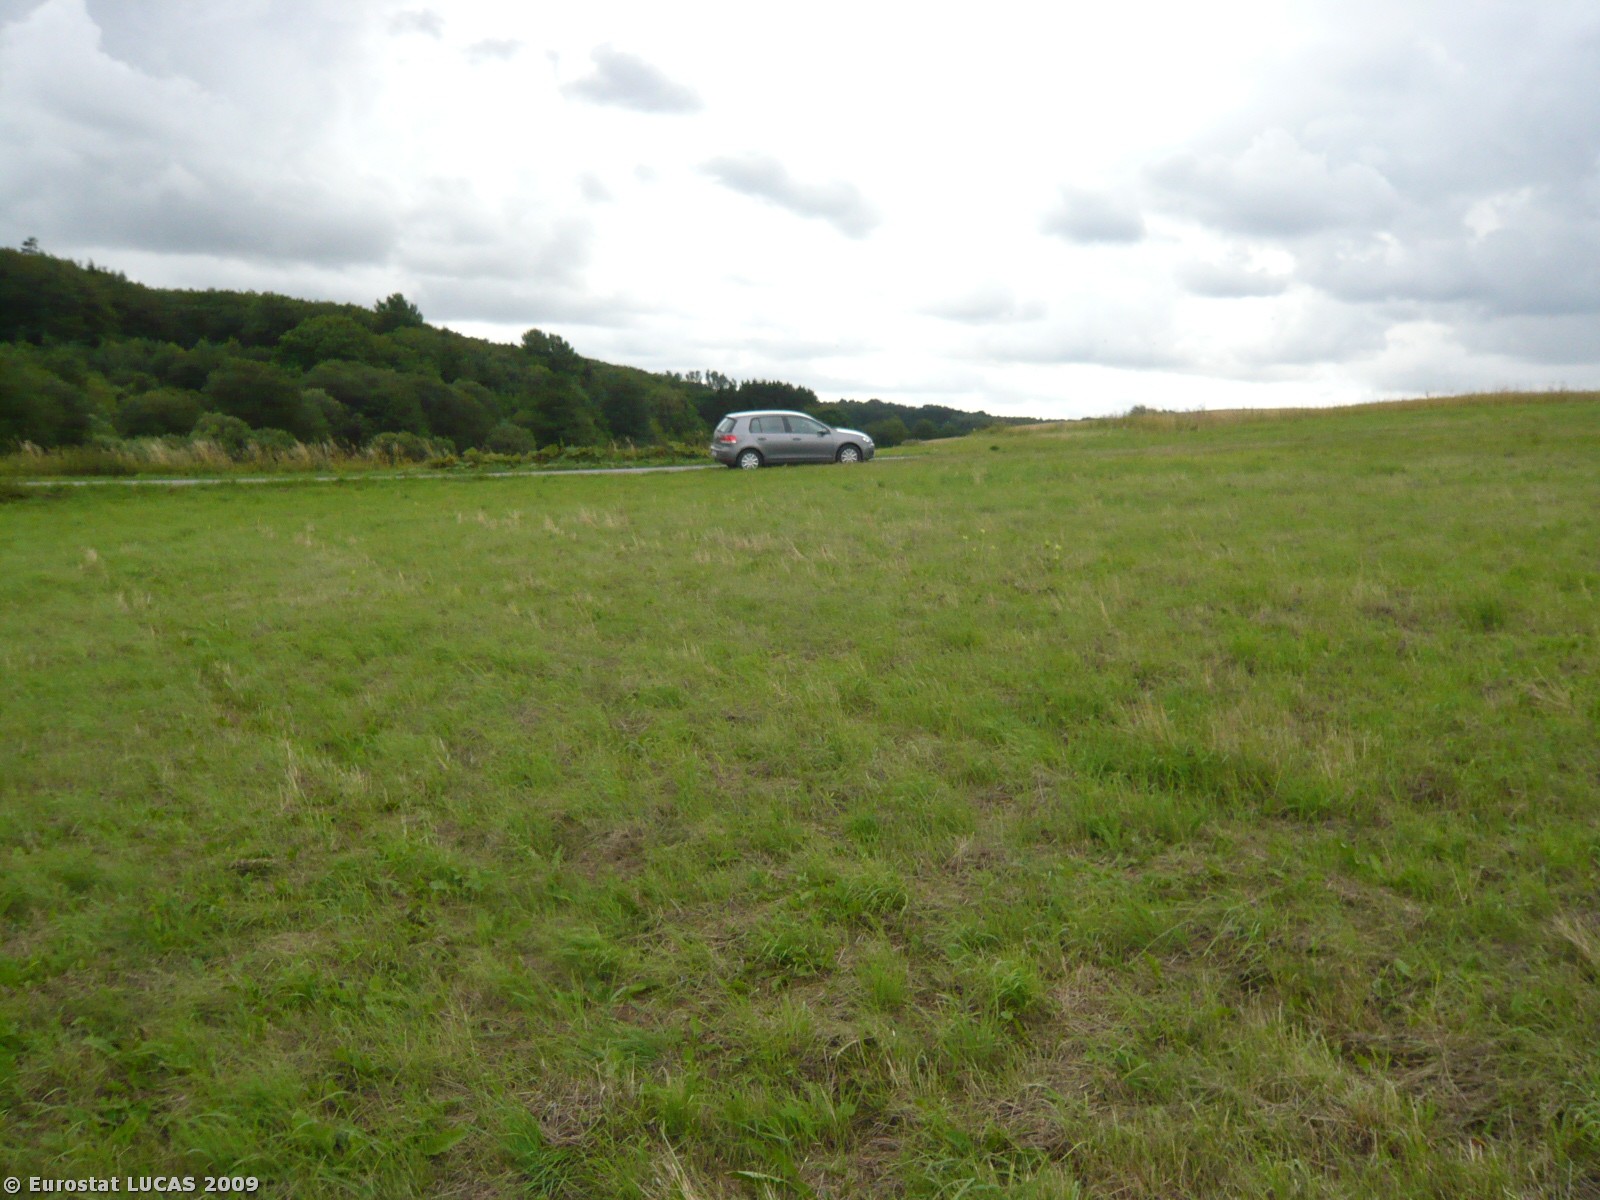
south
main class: Grassland
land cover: Grassland without tree/shrub cover
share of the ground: > 75 %
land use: Agriculture (excluding fallow land and kitchen gardens)
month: July
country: DK
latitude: 55.5252
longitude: 11.9785
